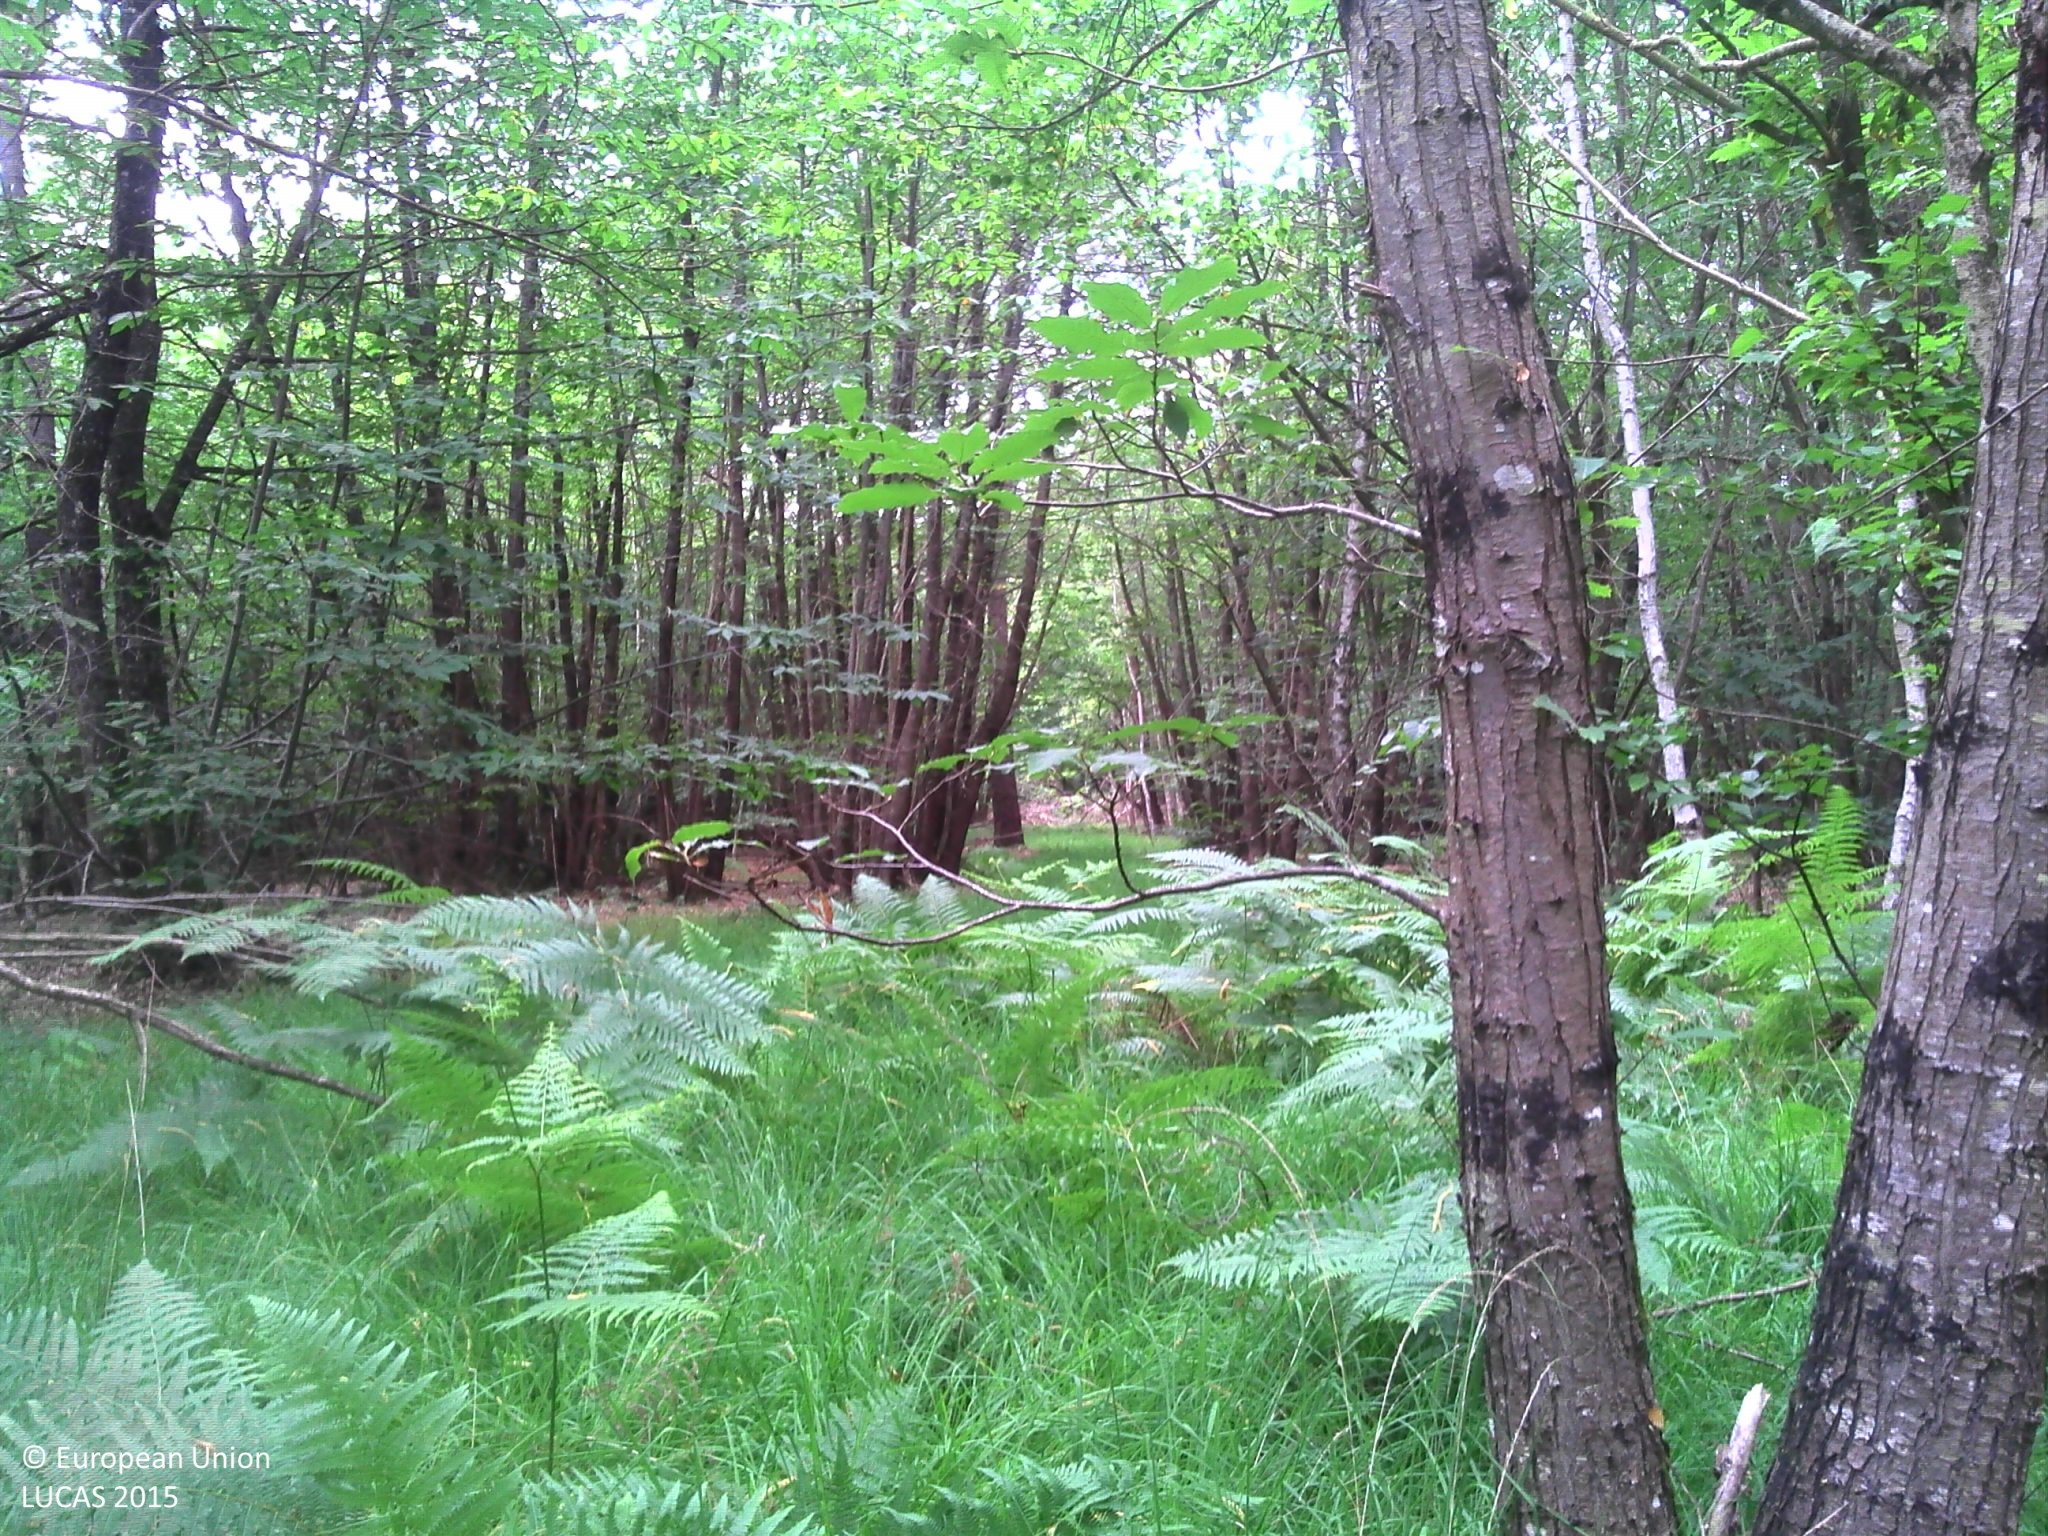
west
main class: Woodland
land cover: Pine dominated mixed woodland
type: acidophilous oak and oak-birch forest
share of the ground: > 75 %
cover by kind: broadleaved forest trees 40 %, coniferous forest trees 30 %, herbaceous plants 20 %, shrubs 5 %, lichens and mosses 5 %
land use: Forestry
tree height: > 5 m
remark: Fire break
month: July
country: FR
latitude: 47.3099
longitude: 0.1480
